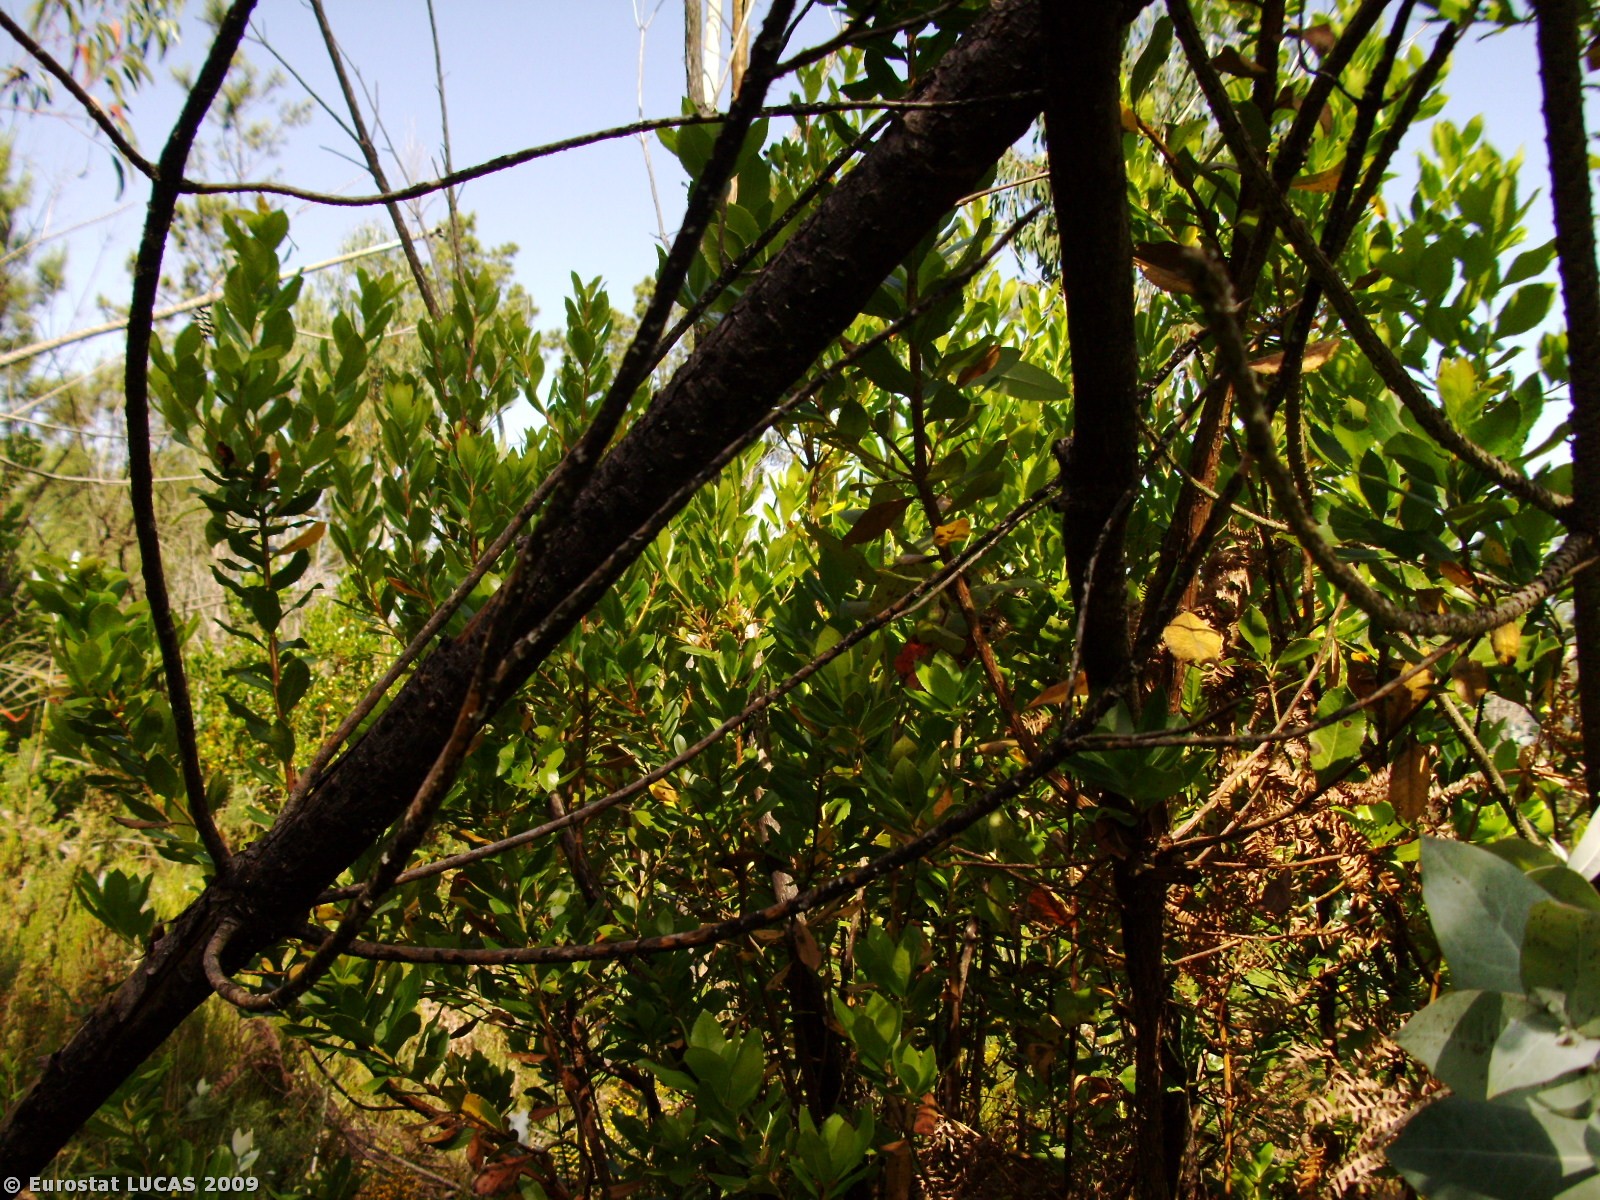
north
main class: Woodland
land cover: Broadleaved woodland
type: plantations and self-sown exotic forest
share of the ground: 50 - 75 %
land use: Forestry
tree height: > 5 m
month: June
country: PT
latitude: 39.9709
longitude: -8.4984
